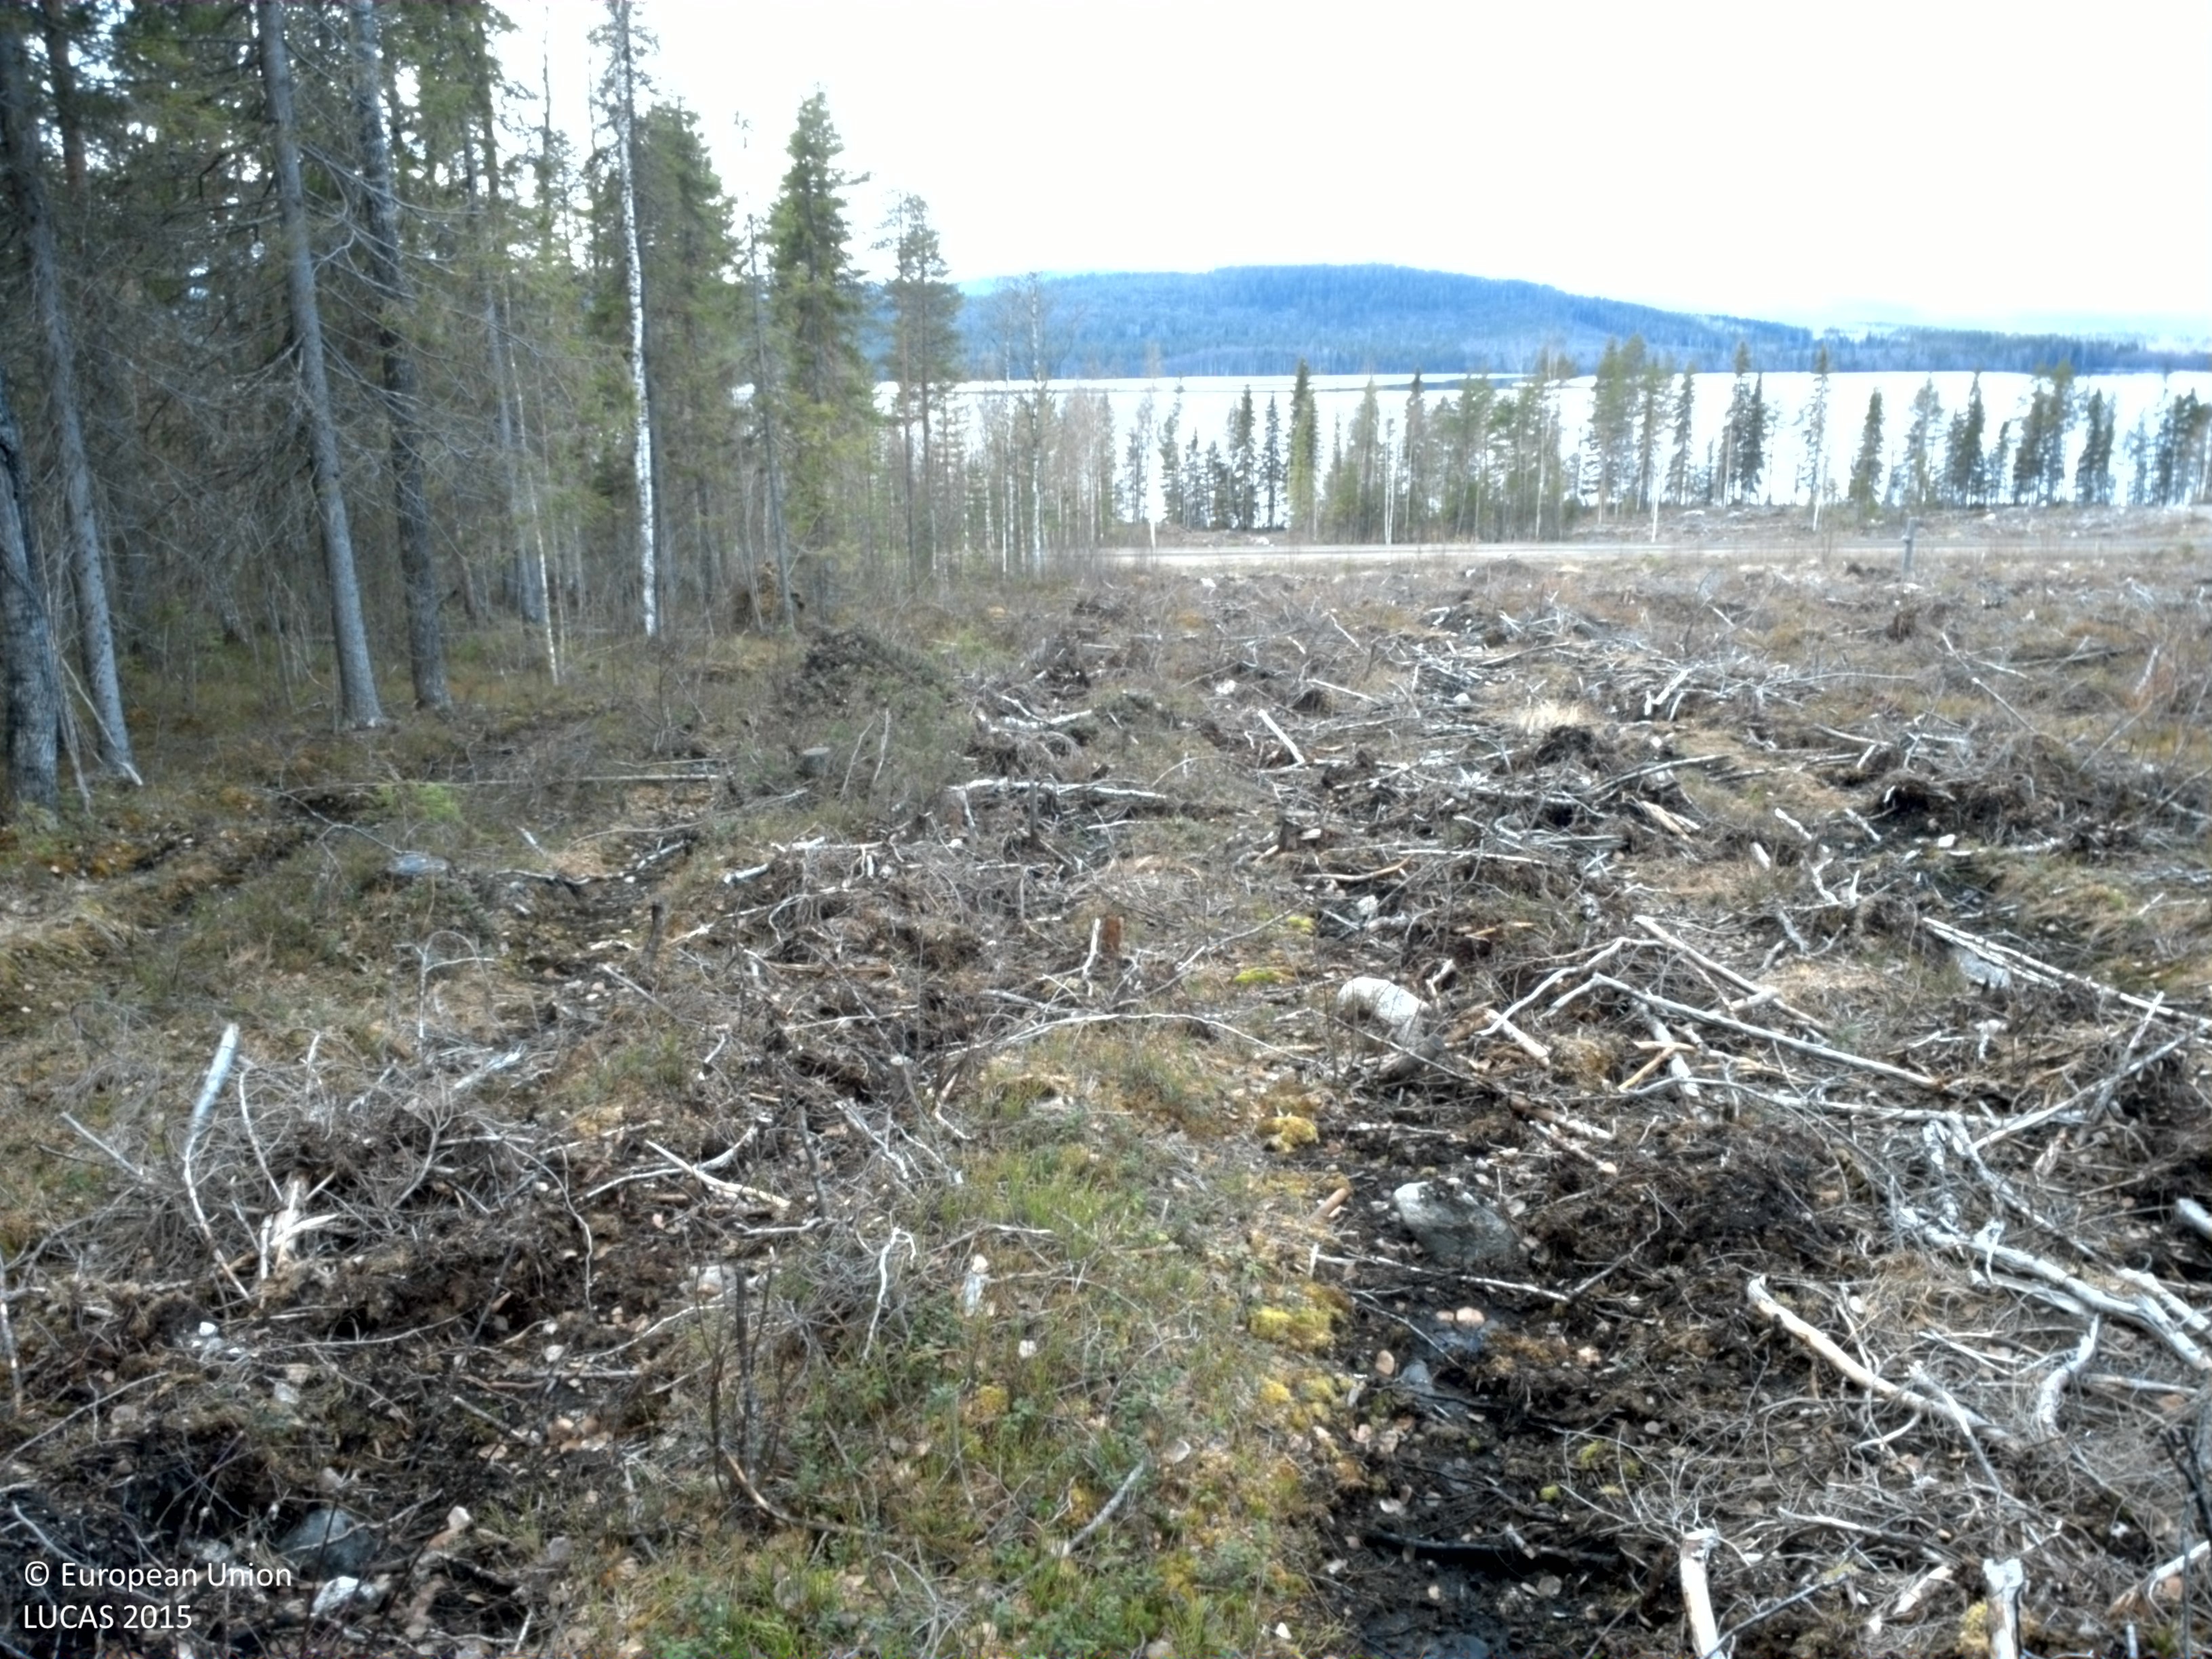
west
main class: Shrubland
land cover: Shrubland with sparse tree cover
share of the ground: 10 - 25 %
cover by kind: shrubs 20 %, unconsolidated bare surface 15 %, broadleaved forest trees 5 %, lichens and mosses 5 %
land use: Forestry
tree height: < 5 m
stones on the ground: 10 - 25 %
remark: Clear cut
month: May
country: SE
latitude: 66.3358
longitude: 23.5395
